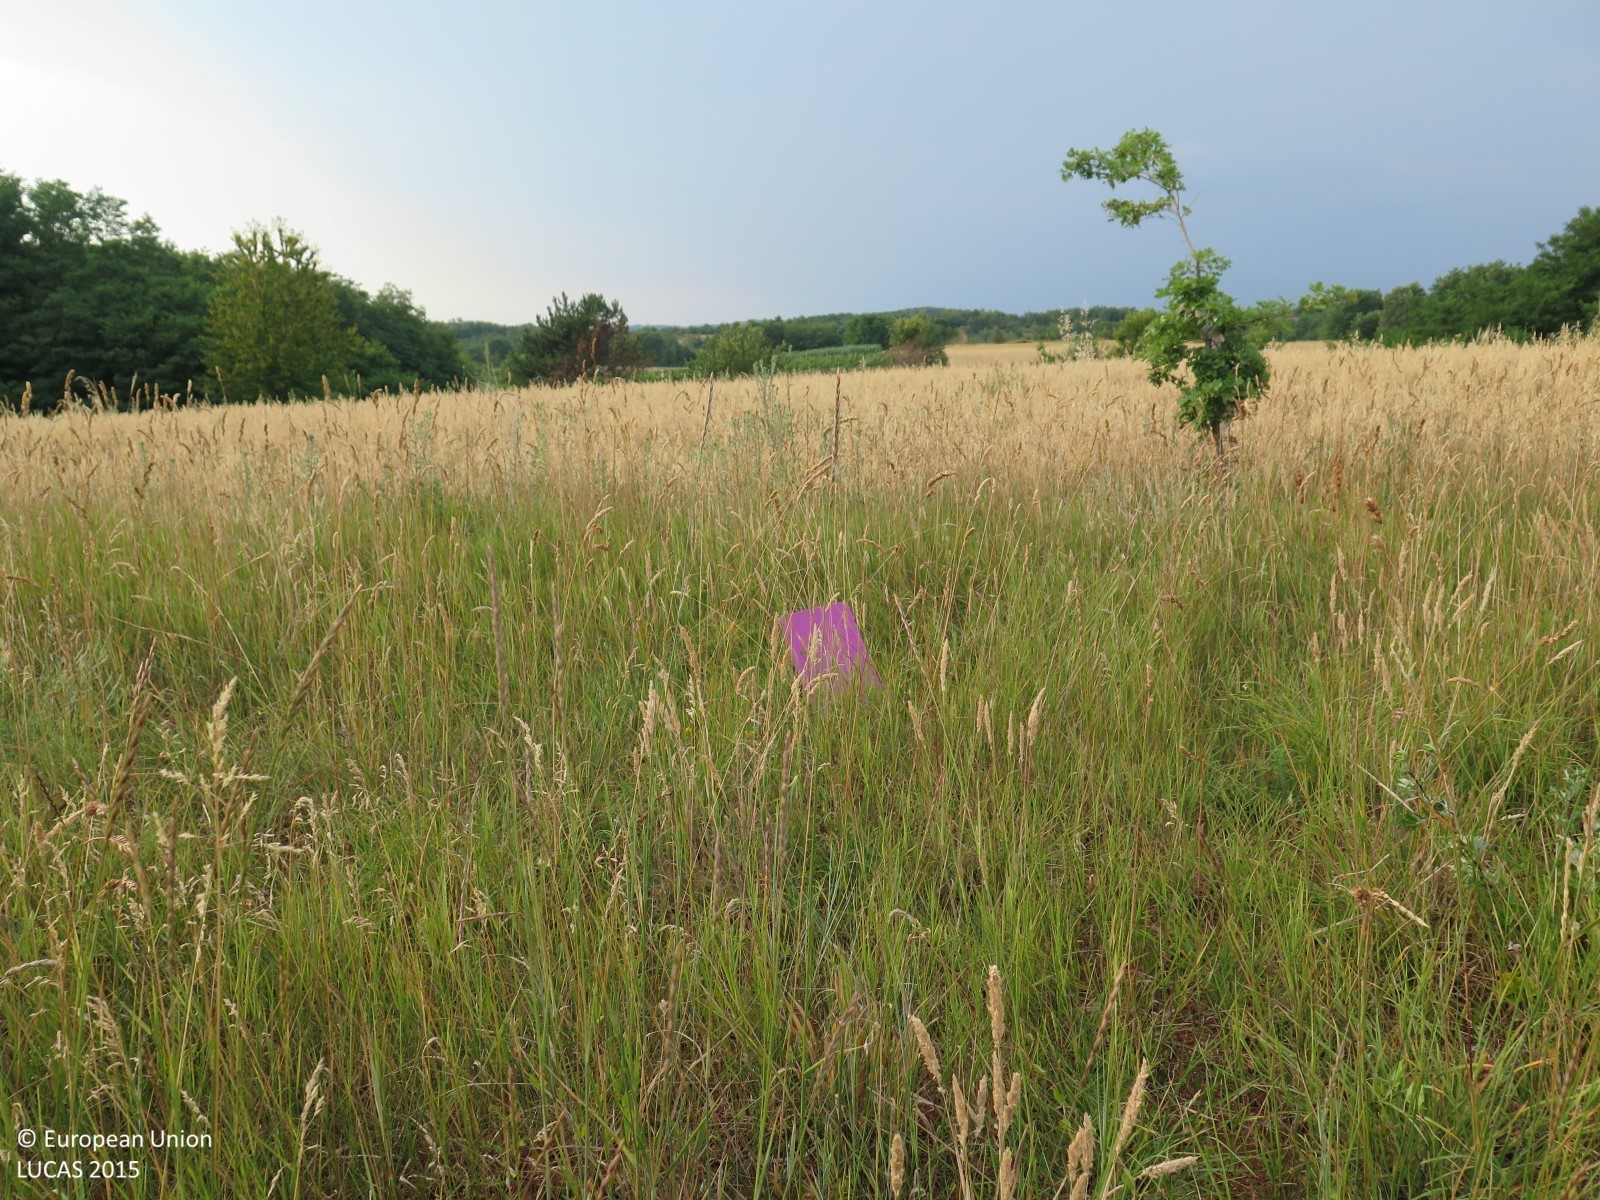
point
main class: Grassland
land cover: Grassland without tree/shrub cover
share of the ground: > 75 %
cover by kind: herbaceous plants 100 %
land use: Agriculture (excluding fallow land and kitchen gardens)
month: July
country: HR
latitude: 45.2545
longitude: 13.8303
